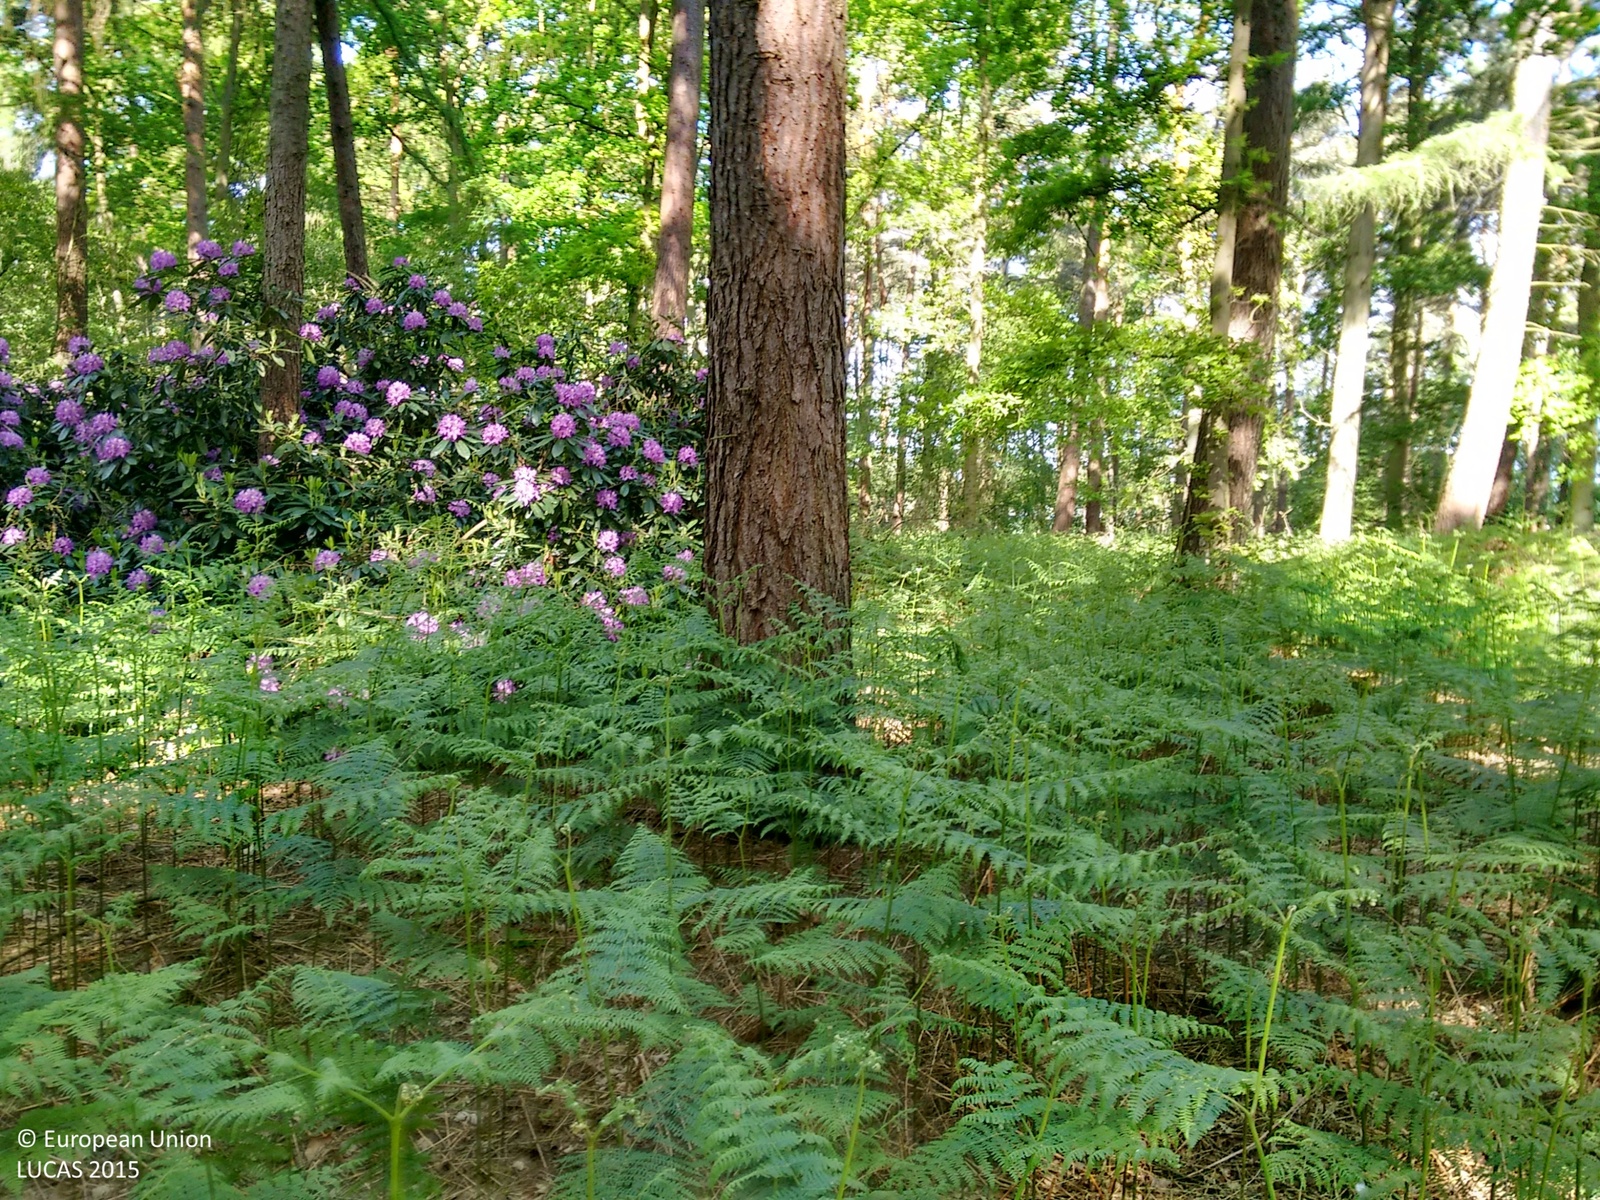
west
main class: Woodland
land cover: Other mixed woodland
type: mesophytic deciduous forest
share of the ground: > 75 %
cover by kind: broadleaved forest trees 65 %, coniferous forest trees 35 %
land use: Forestry
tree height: > 5 m
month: June
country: GB
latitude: 53.9575
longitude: -0.9386
